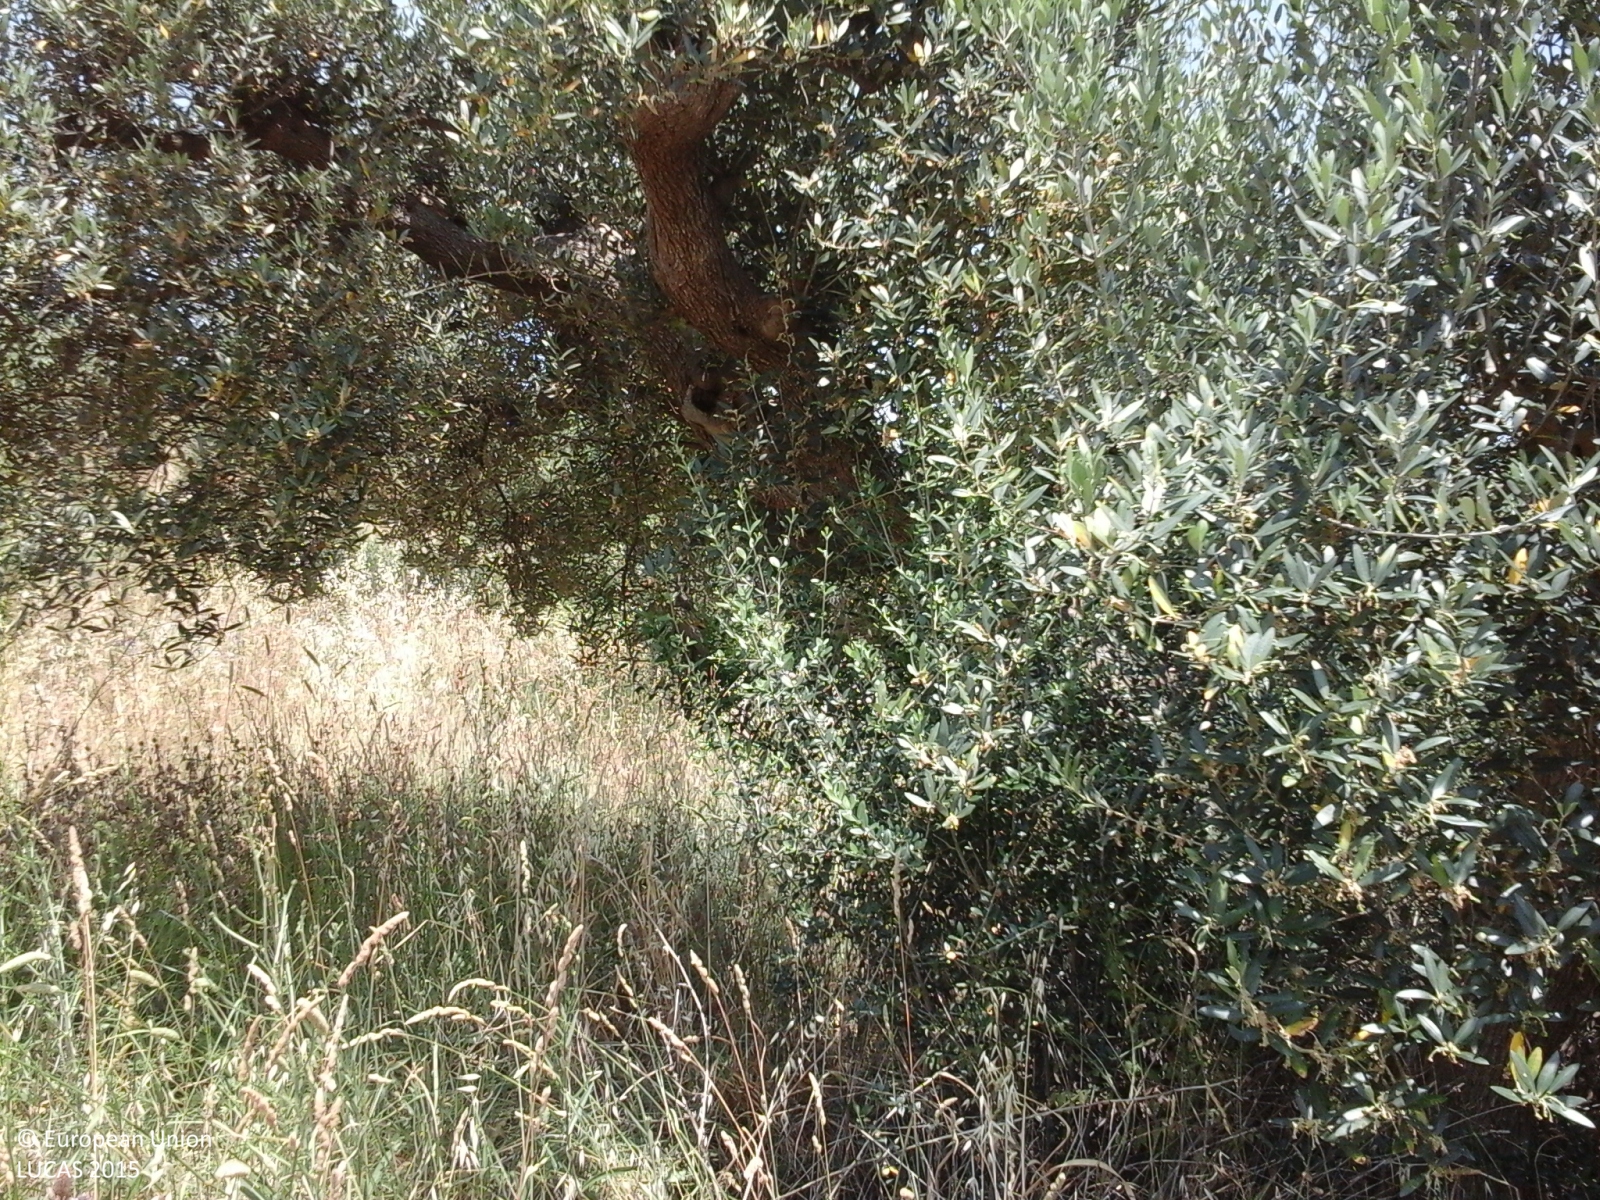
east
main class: Cropland
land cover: Vineyards
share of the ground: 25 - 50 %
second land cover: Spontaneously vegetated surfaces
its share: 25 - 50 %
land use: Agriculture (excluding fallow land and kitchen gardens)
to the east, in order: Grass margins; Olive groves; Paved roads, cycling and walking lanes; Ditches and canals; Olive groves; Spontaneously vegetated surfaces; Abandoned hedges; Paved roads, cycling and walking lanes; Olive groves; Abandoned hedges; Electric lines; Olive groves; Tomatoes; Olive groves; Grassland with sparse tree/shrub cover; Tracks; Olive groves
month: June
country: IT
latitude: 42.1964
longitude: 14.4066
